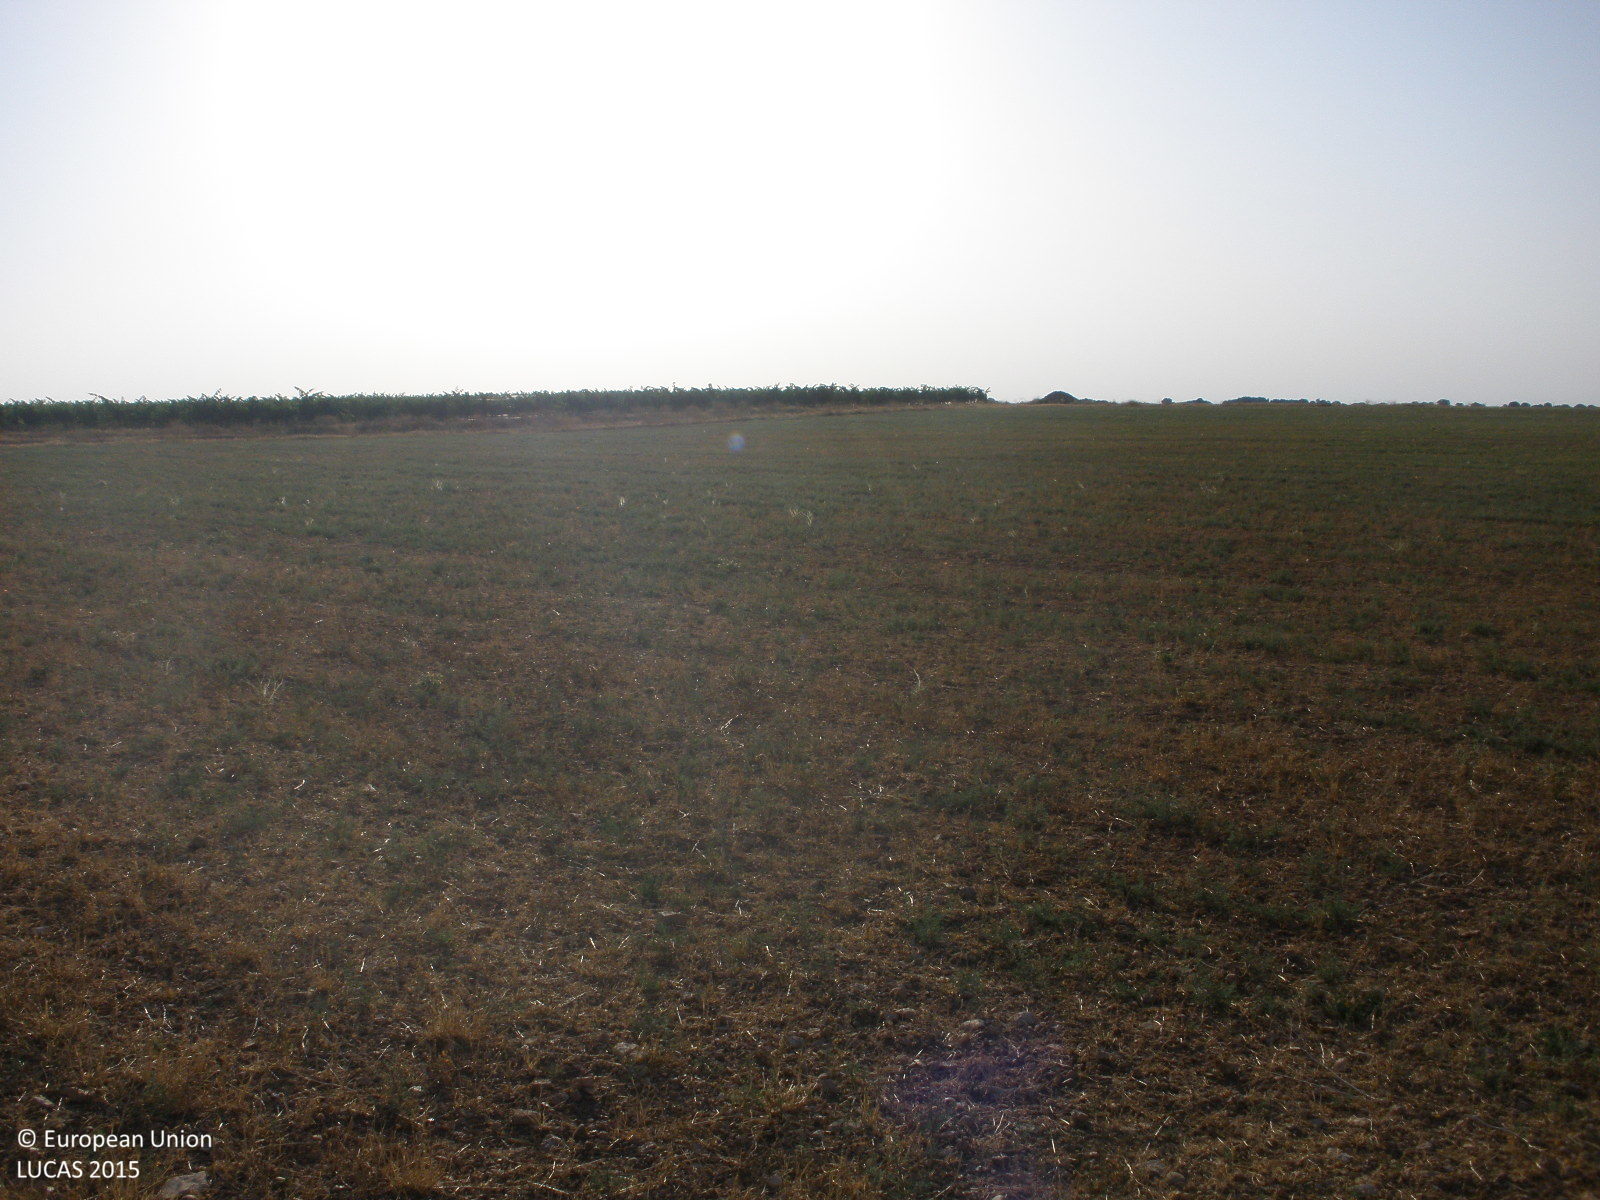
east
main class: Grassland
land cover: Spontaneously vegetated surfaces
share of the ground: > 75 %
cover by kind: herbaceous plants 85 %, unconsolidated bare surface 15 %
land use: Fallow land
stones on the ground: 25 - 50 %
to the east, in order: Spontaneously vegetated surfaces; Tracks; Dry stone walls; Other bare soil
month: July
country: ES
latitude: 39.9242
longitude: -3.3060
